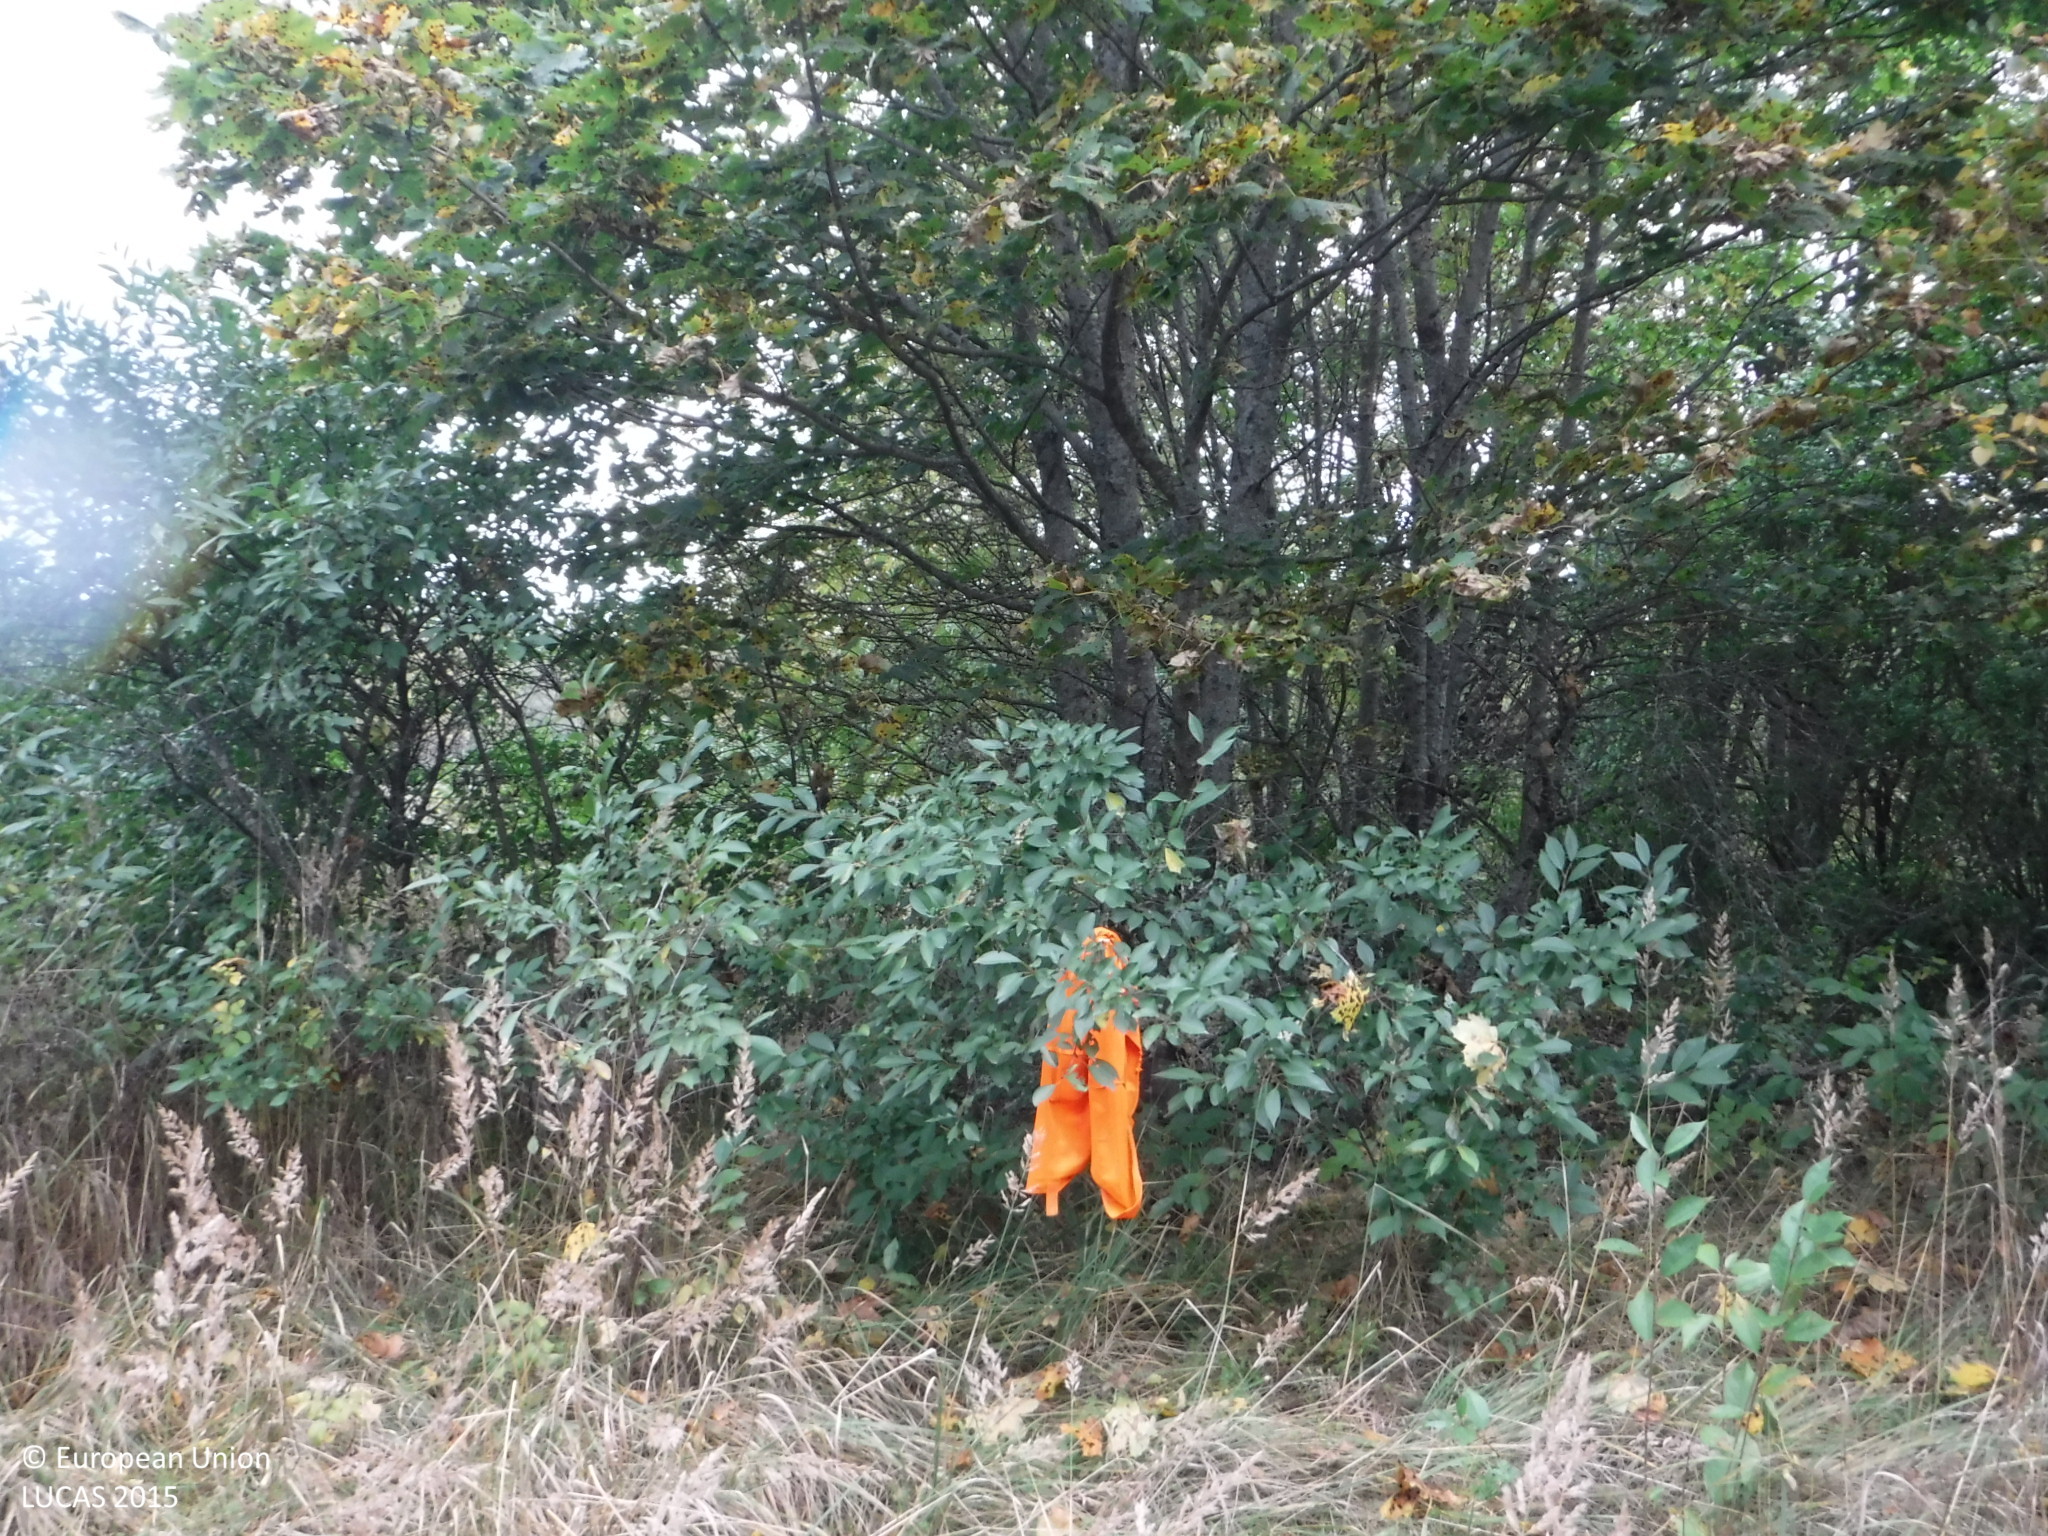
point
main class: Woodland
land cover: Broadleaved woodland
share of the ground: > 75 %
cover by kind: broadleaved forest trees 80 %, herbaceous plants 20 %
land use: Semi-natural and natural areas not in use
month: September
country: FI
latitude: 61.4871
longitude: 24.0805
